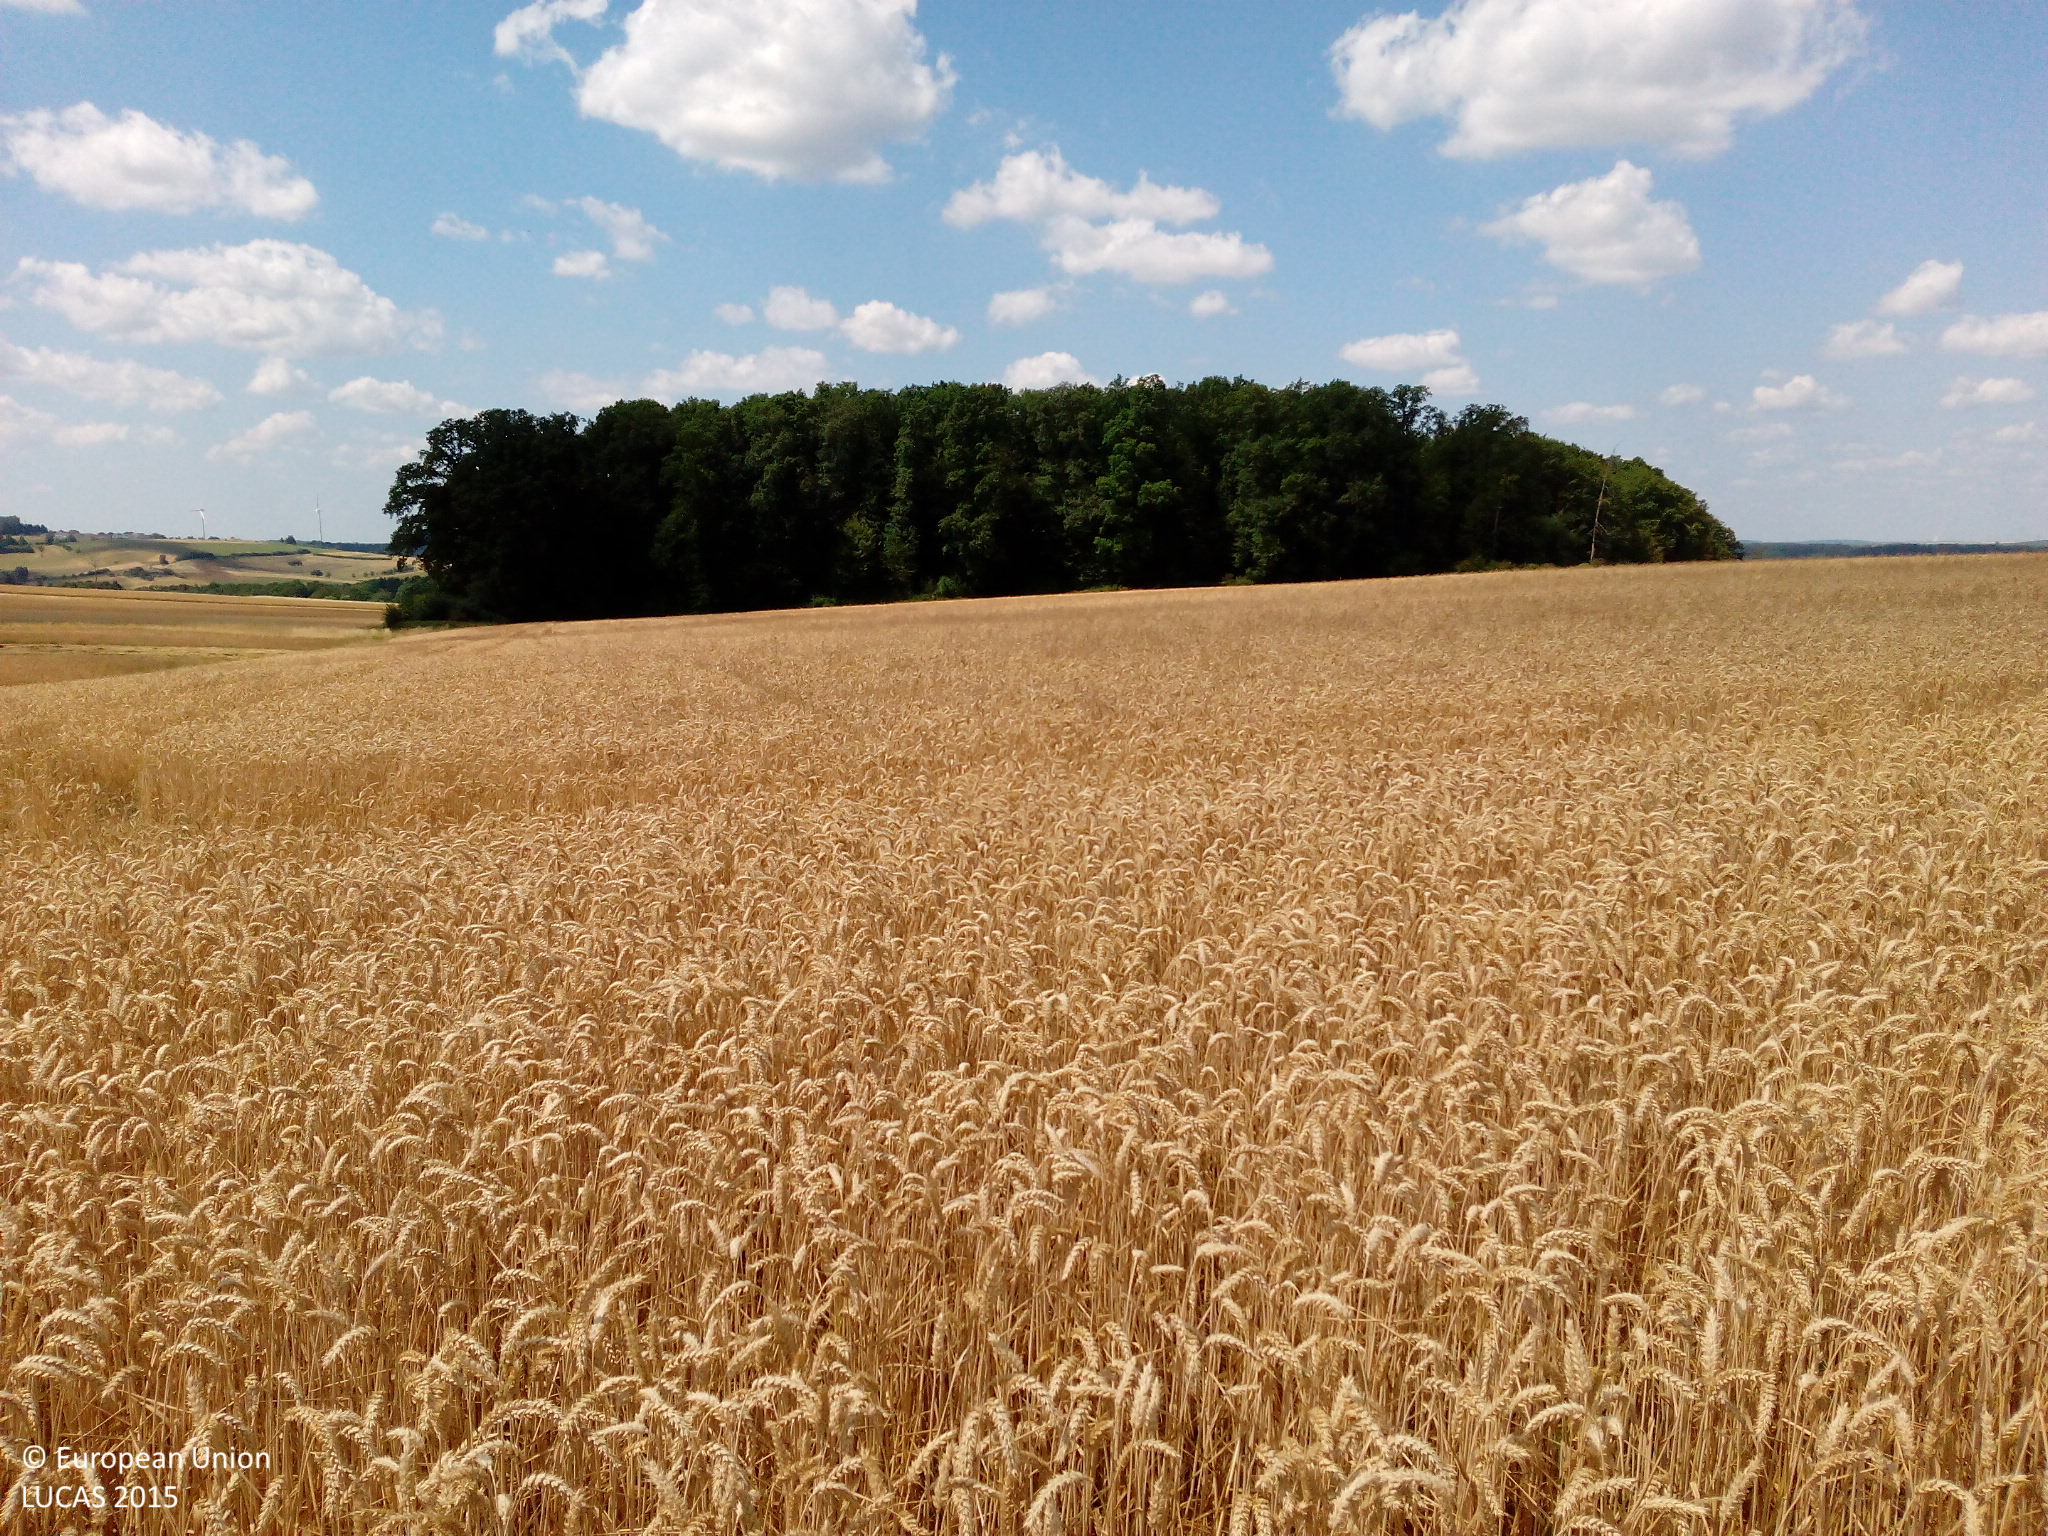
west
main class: Grassland
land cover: Grassland without tree/shrub cover
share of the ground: > 75 %
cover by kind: herbaceous plants 90 %, unconsolidated bare surface 10 %
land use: Agriculture (excluding fallow land and kitchen gardens)
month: July
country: DE
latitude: 49.2401
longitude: 7.5419
